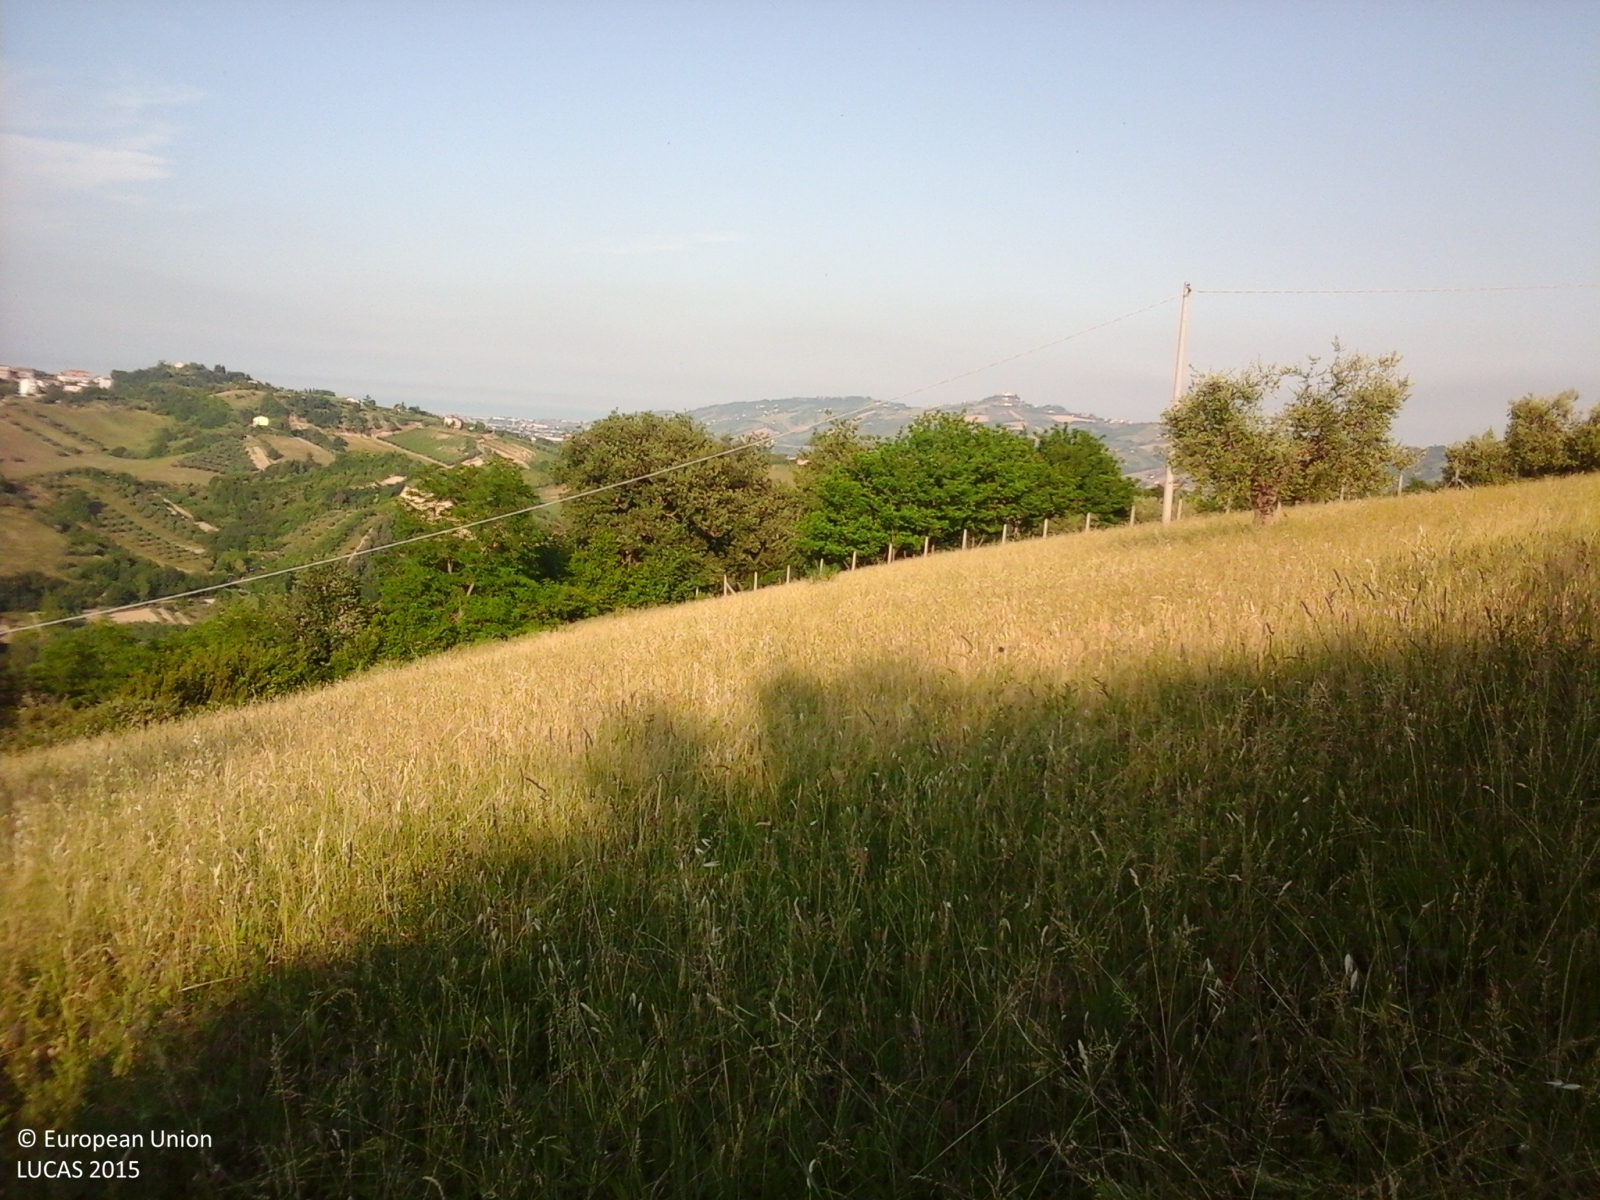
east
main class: Shrubland
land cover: Shrubland without tree cover
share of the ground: > 75 %
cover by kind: shrubs 100 %
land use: Semi-natural and natural areas not in use
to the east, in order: Shrubland without tree cover; Spontaneously vegetated surfaces; Electric lines; Spontaneously vegetated surfaces; Broadleaved woodland
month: June
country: IT
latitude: 42.8910
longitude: 13.7733
